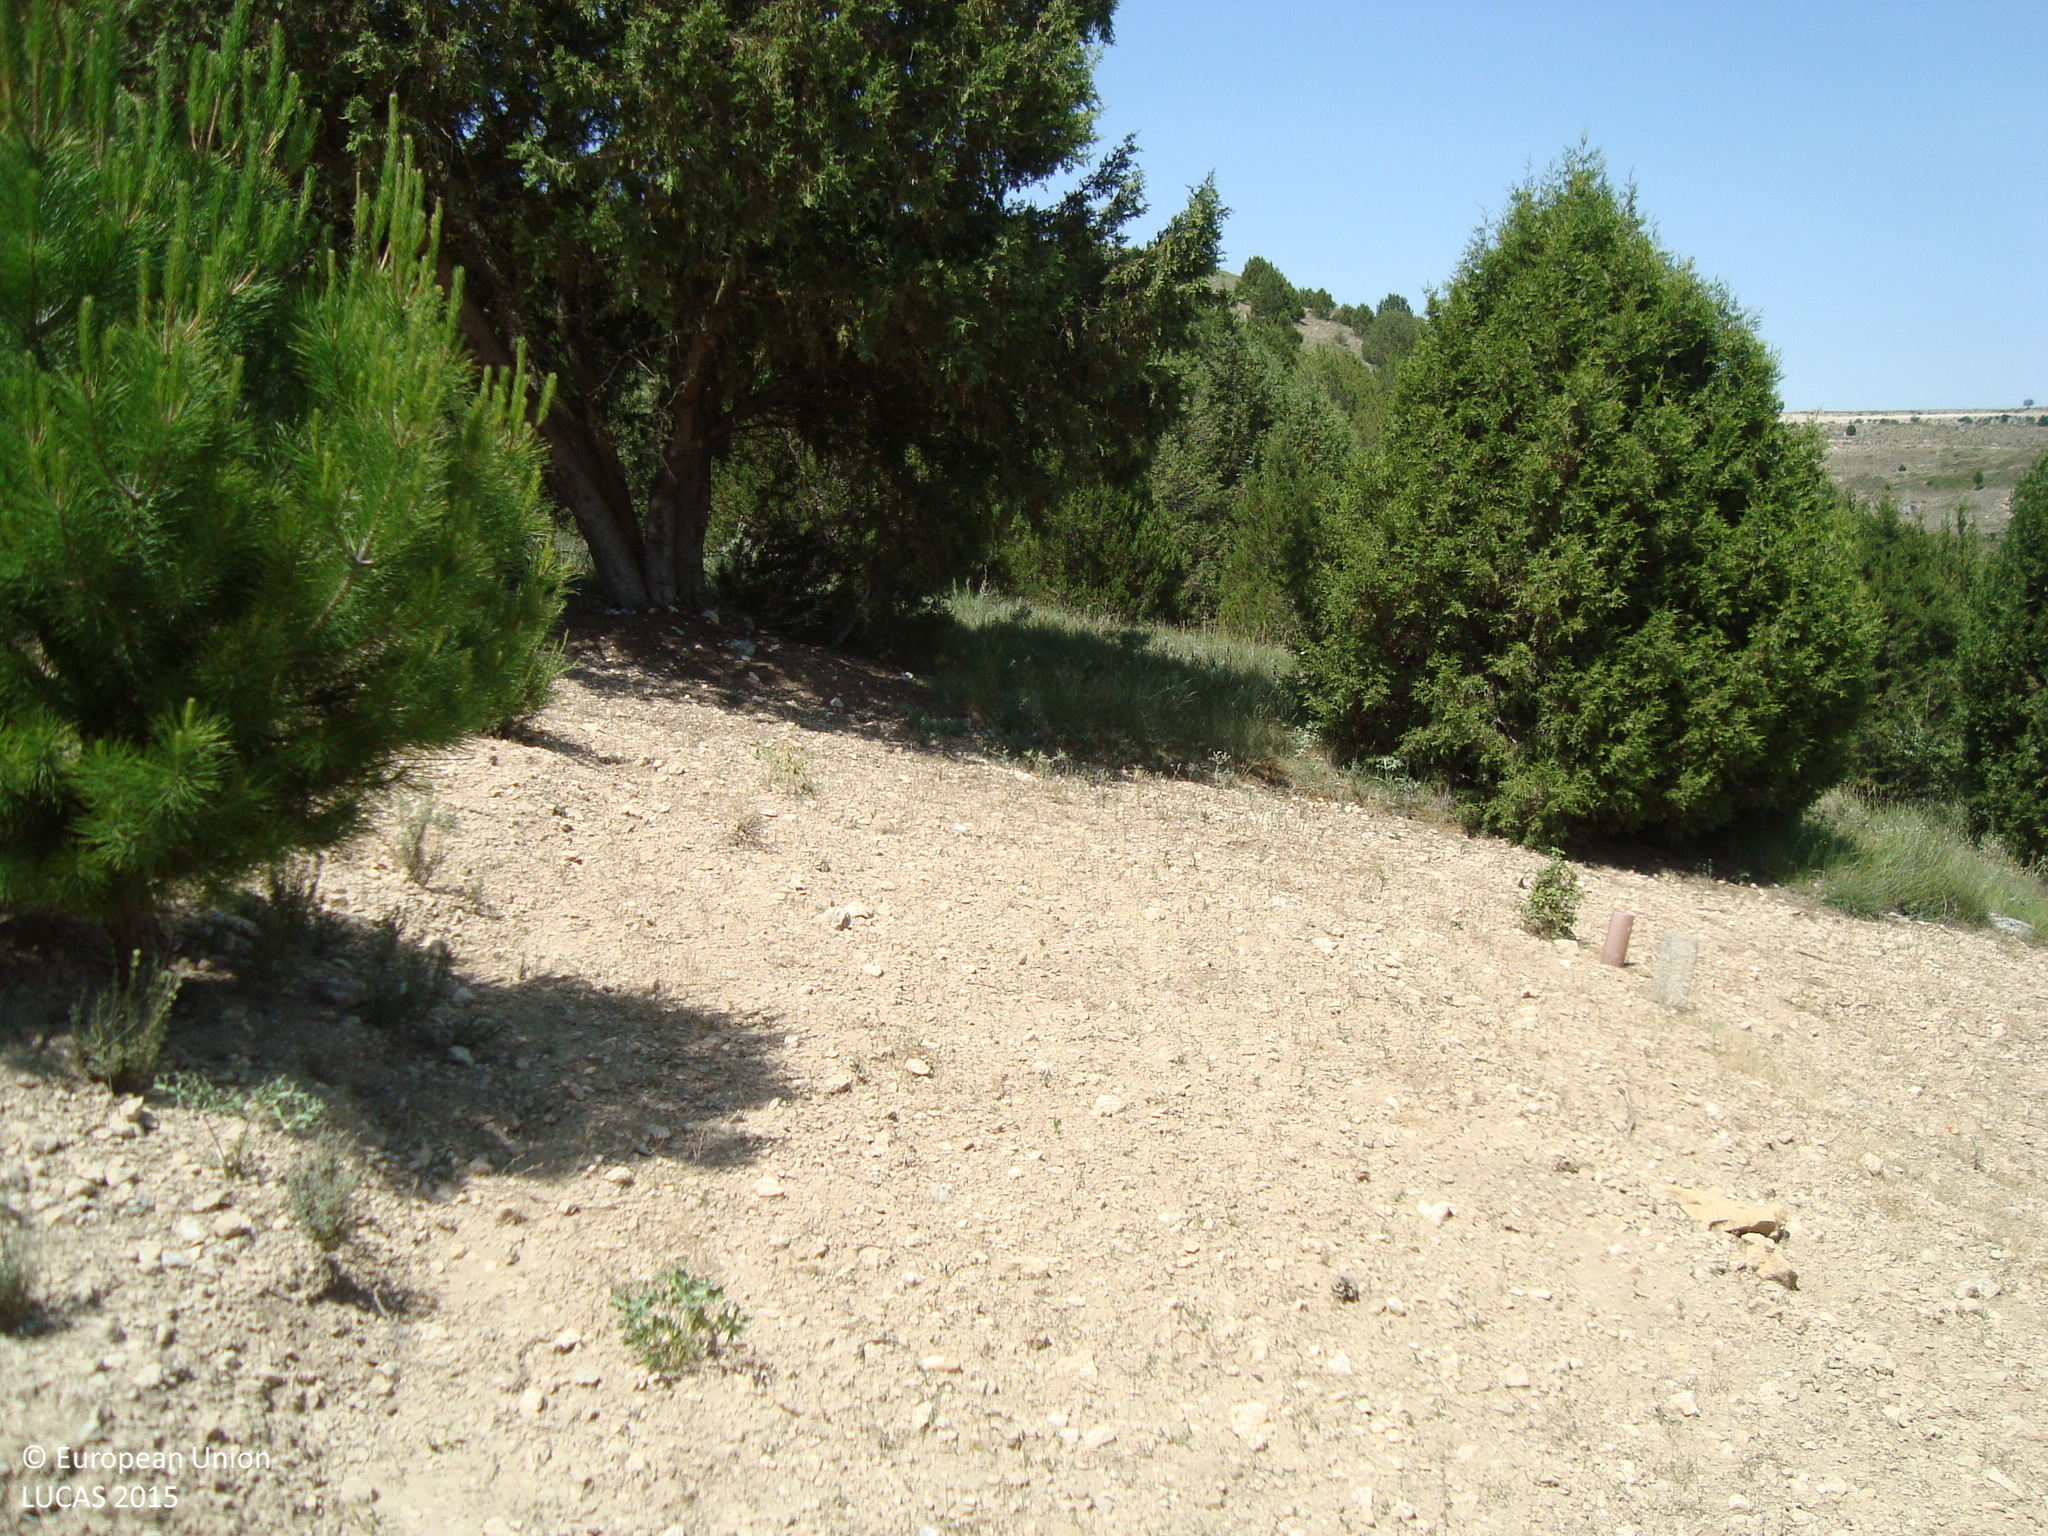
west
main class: Woodland
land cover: Pine dominated coniferous woodland
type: coniferous forest of the mediterranean region
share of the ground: 50 - 75 %
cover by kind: coniferous forest trees 45 %, unconsolidated bare surface 30 %, broadleaved forest trees 10 %, herbaceous plants 10 %, shrubs 5 %
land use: Forestry
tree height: < 5 m
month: July
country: ES
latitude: 41.8475
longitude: -3.8232
